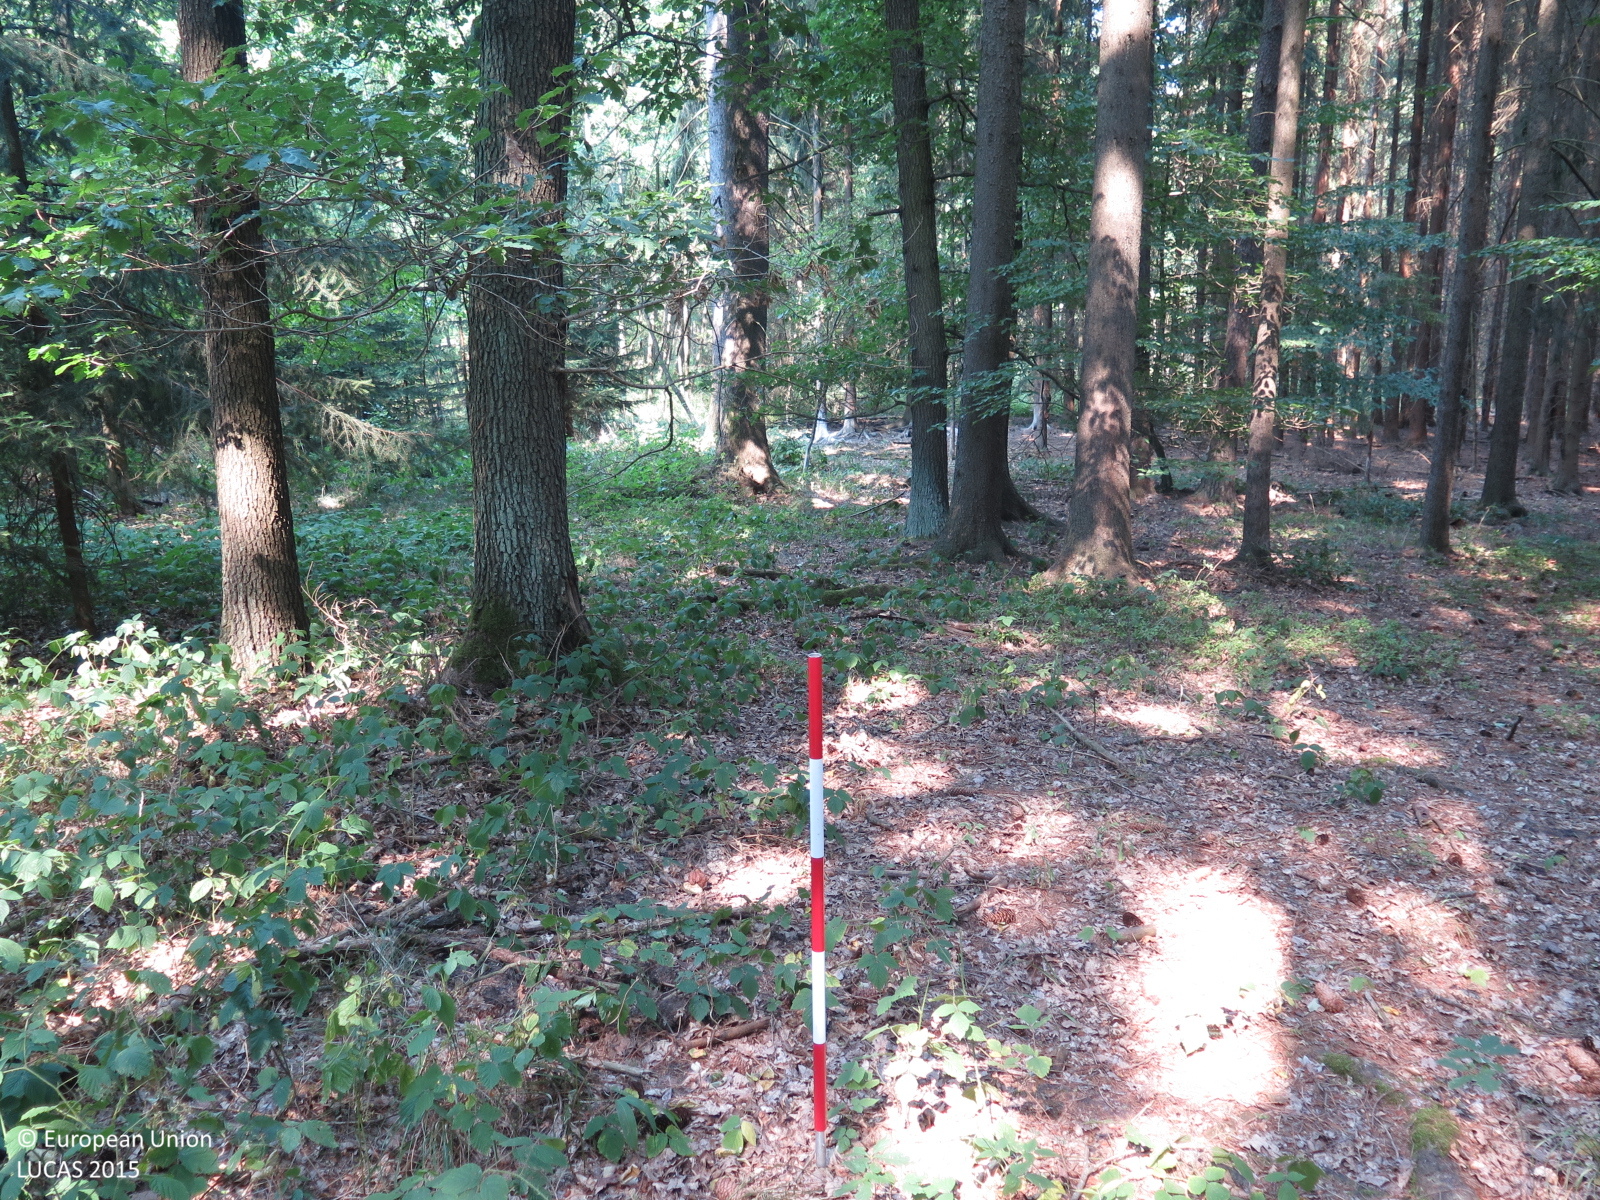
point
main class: Woodland
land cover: Spruce dominated mixed woodland
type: hemiboreal forest and nemoral coniferous forest and mixed broadleaved-coniferous forest
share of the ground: > 75 %
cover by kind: coniferous forest trees 65 %, broadleaved forest trees 30 %, herbaceous plants 5 %
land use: Forestry
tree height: > 5 m
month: August
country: CZ
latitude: 49.8860
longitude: 13.8281
